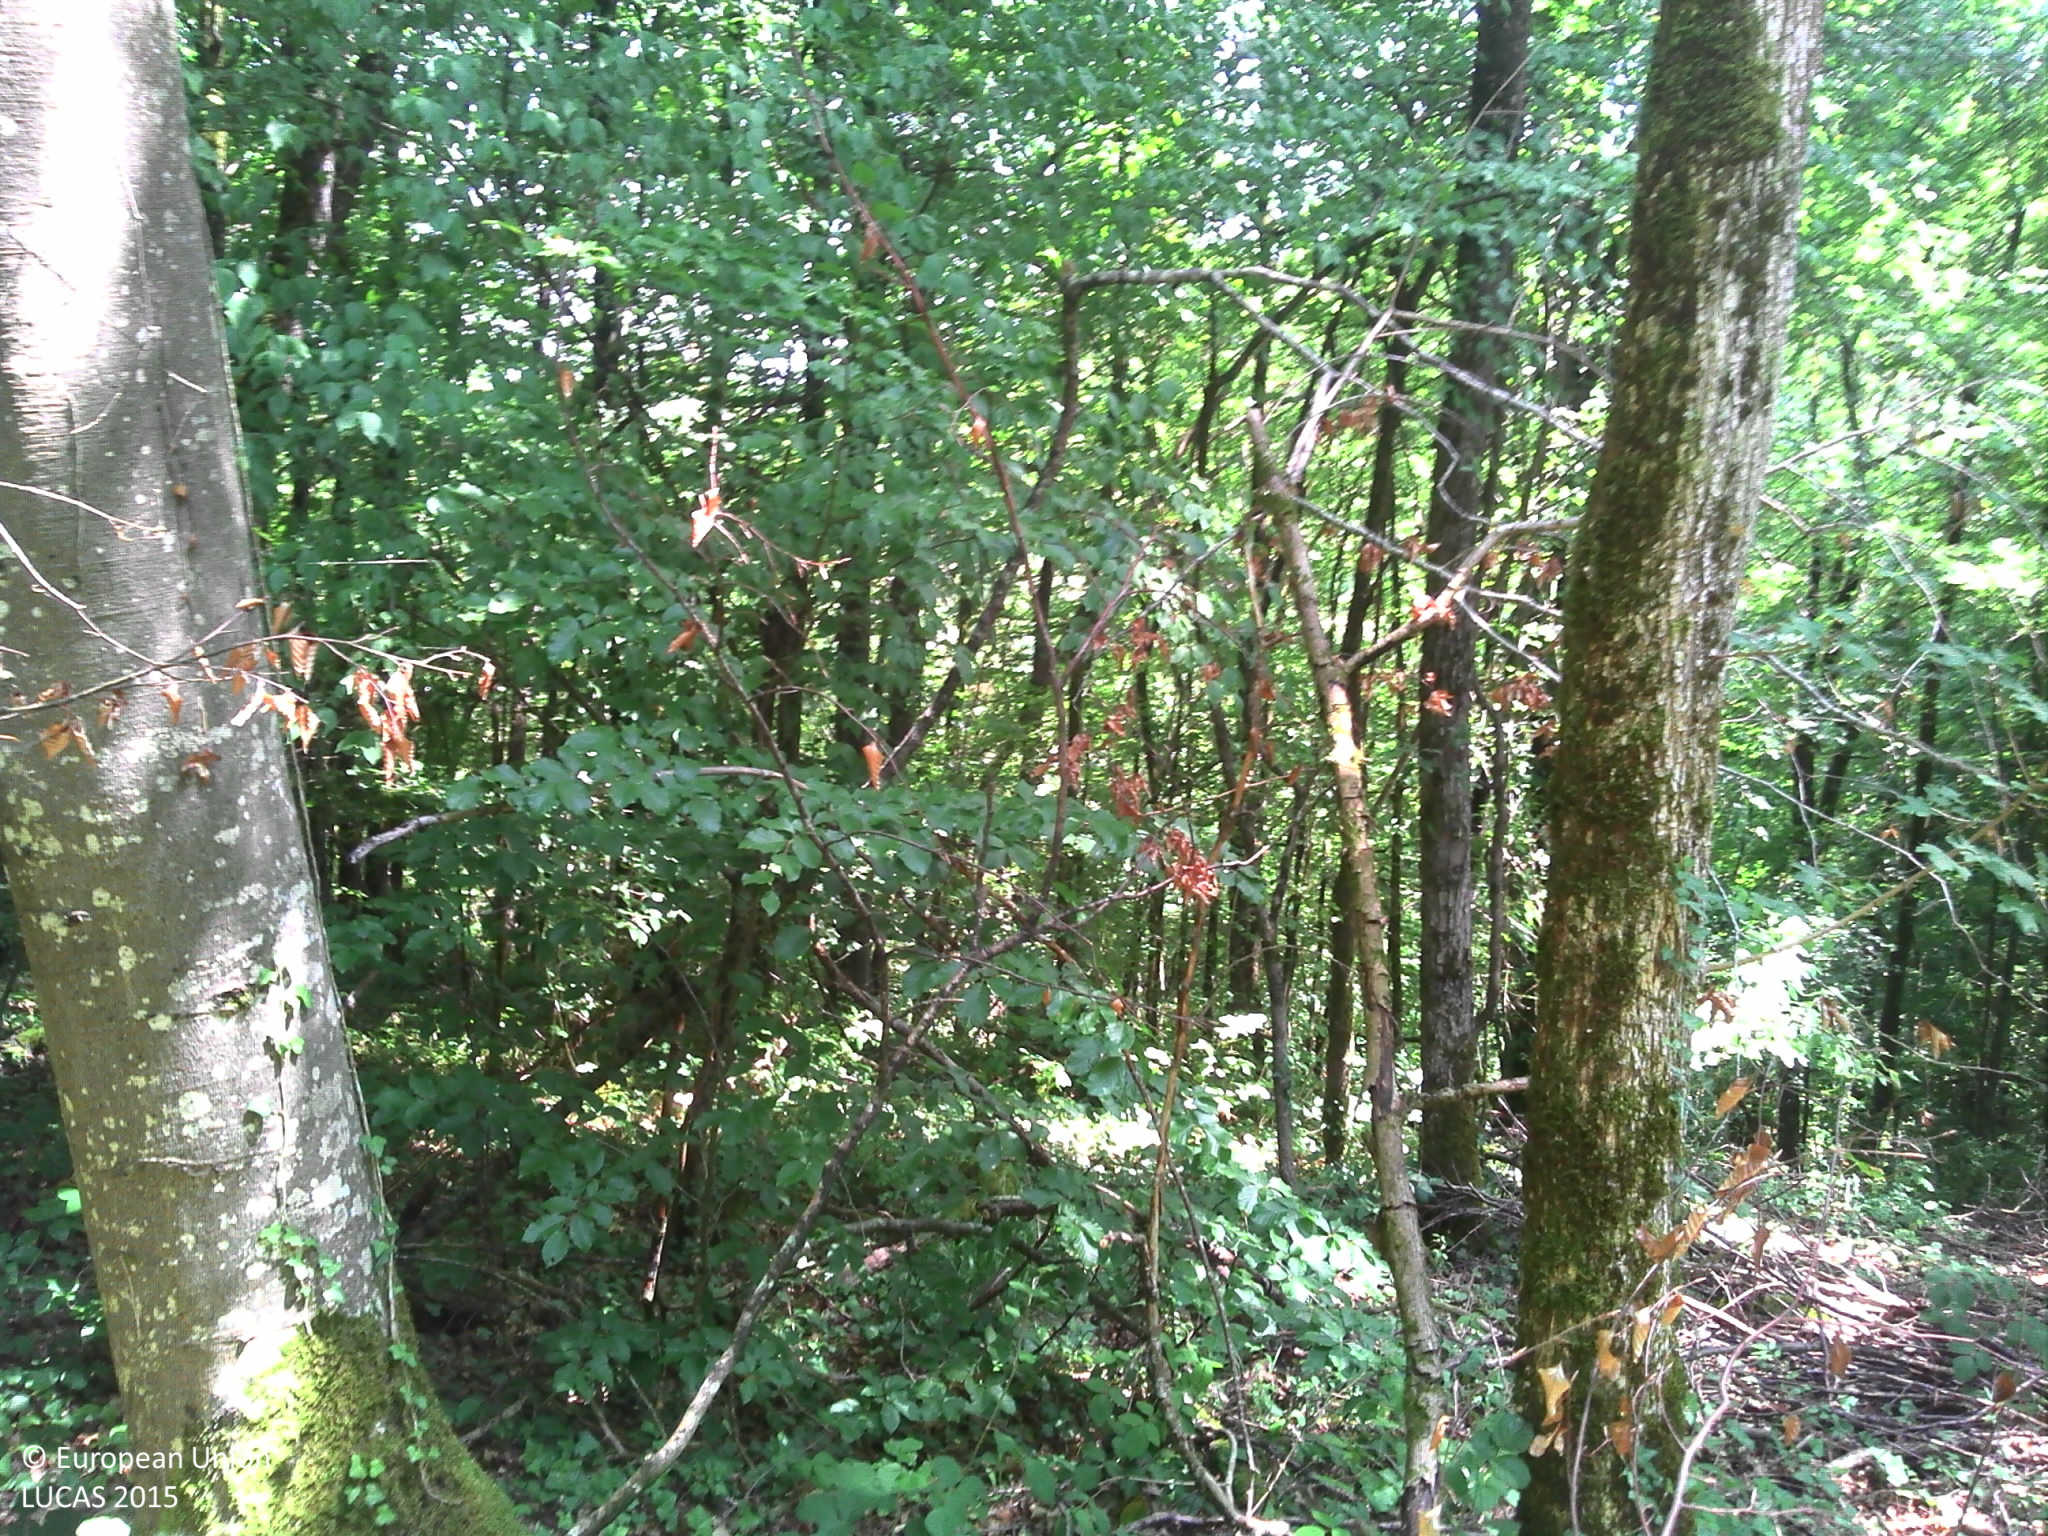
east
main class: Woodland
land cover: Broadleaved woodland
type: beech forest
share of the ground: > 75 %
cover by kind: broadleaved forest trees 85 %, lichens and mosses 10 %, herbaceous plants 5 %
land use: Forestry
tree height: > 5 m
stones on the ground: < 10 %
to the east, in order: Broadleaved woodland; Tracks; Broadleaved woodland
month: July
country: FR
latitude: 48.1214
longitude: 4.8534
